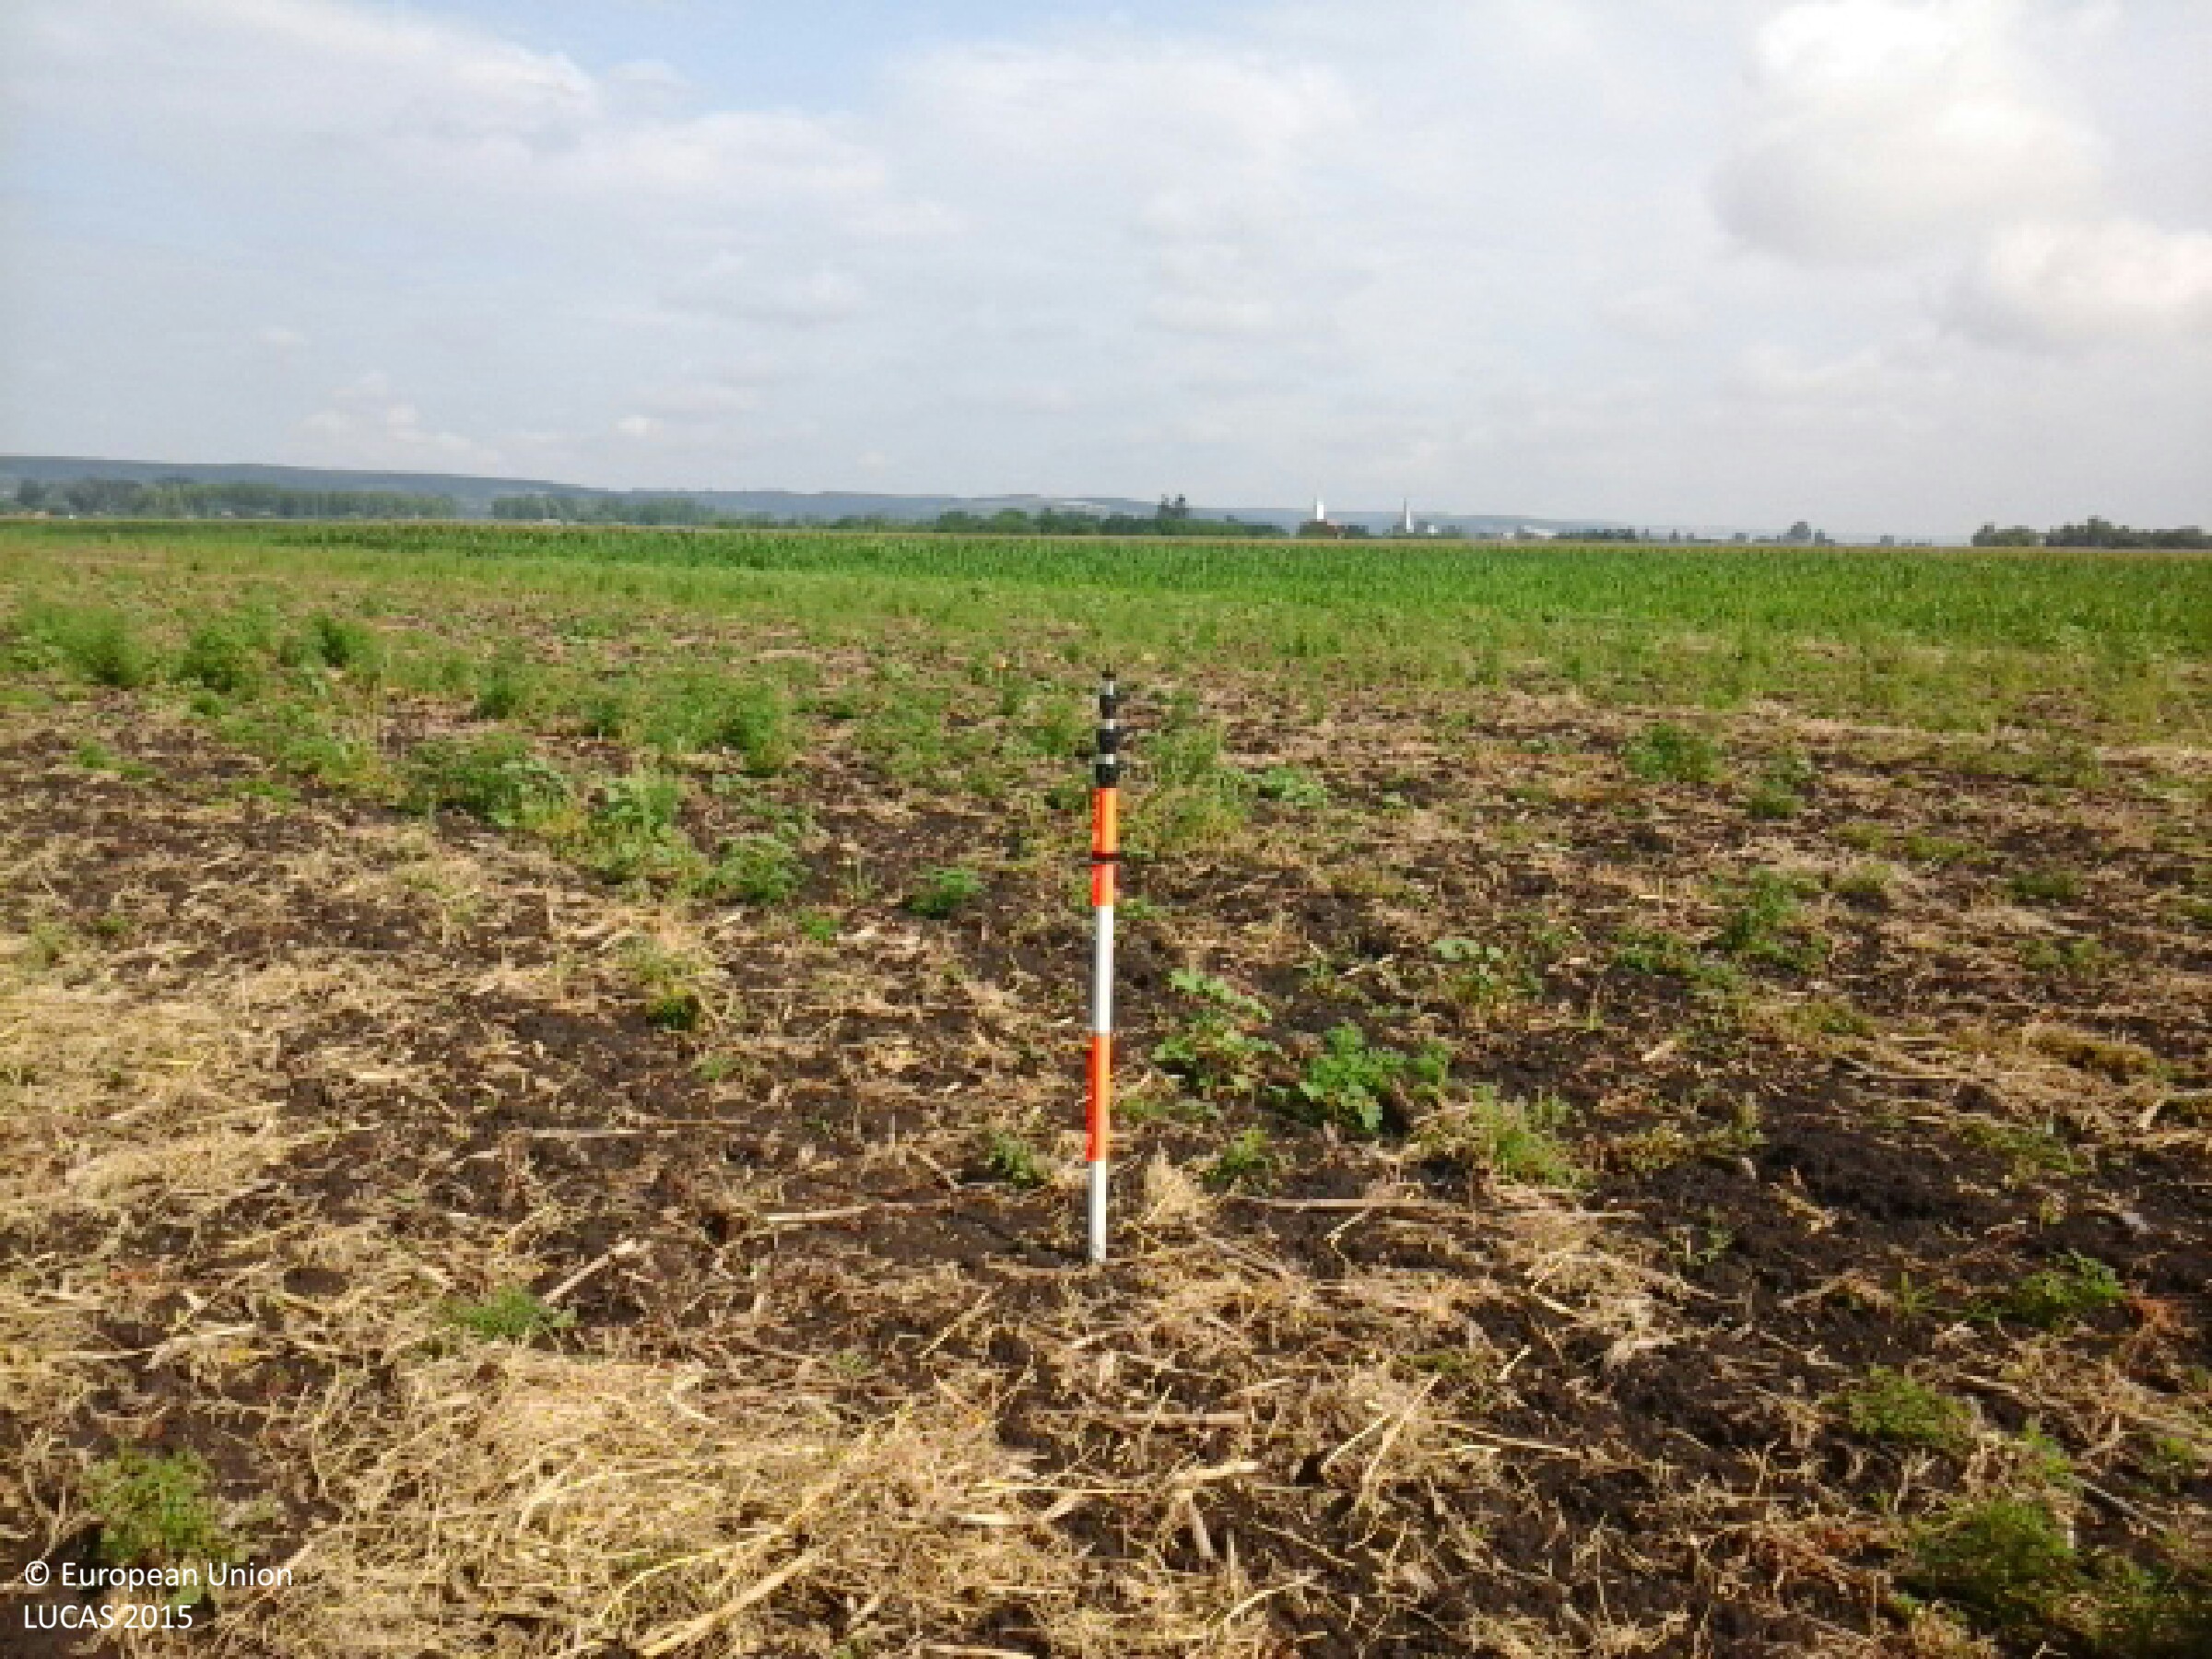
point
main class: Grassland
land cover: Spontaneously vegetated surfaces
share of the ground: 10 - 25 %
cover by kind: herbaceous plants 60 %, unconsolidated bare surface 40 %
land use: Fallow land
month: July
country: HU
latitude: 48.2001
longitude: 20.9779
